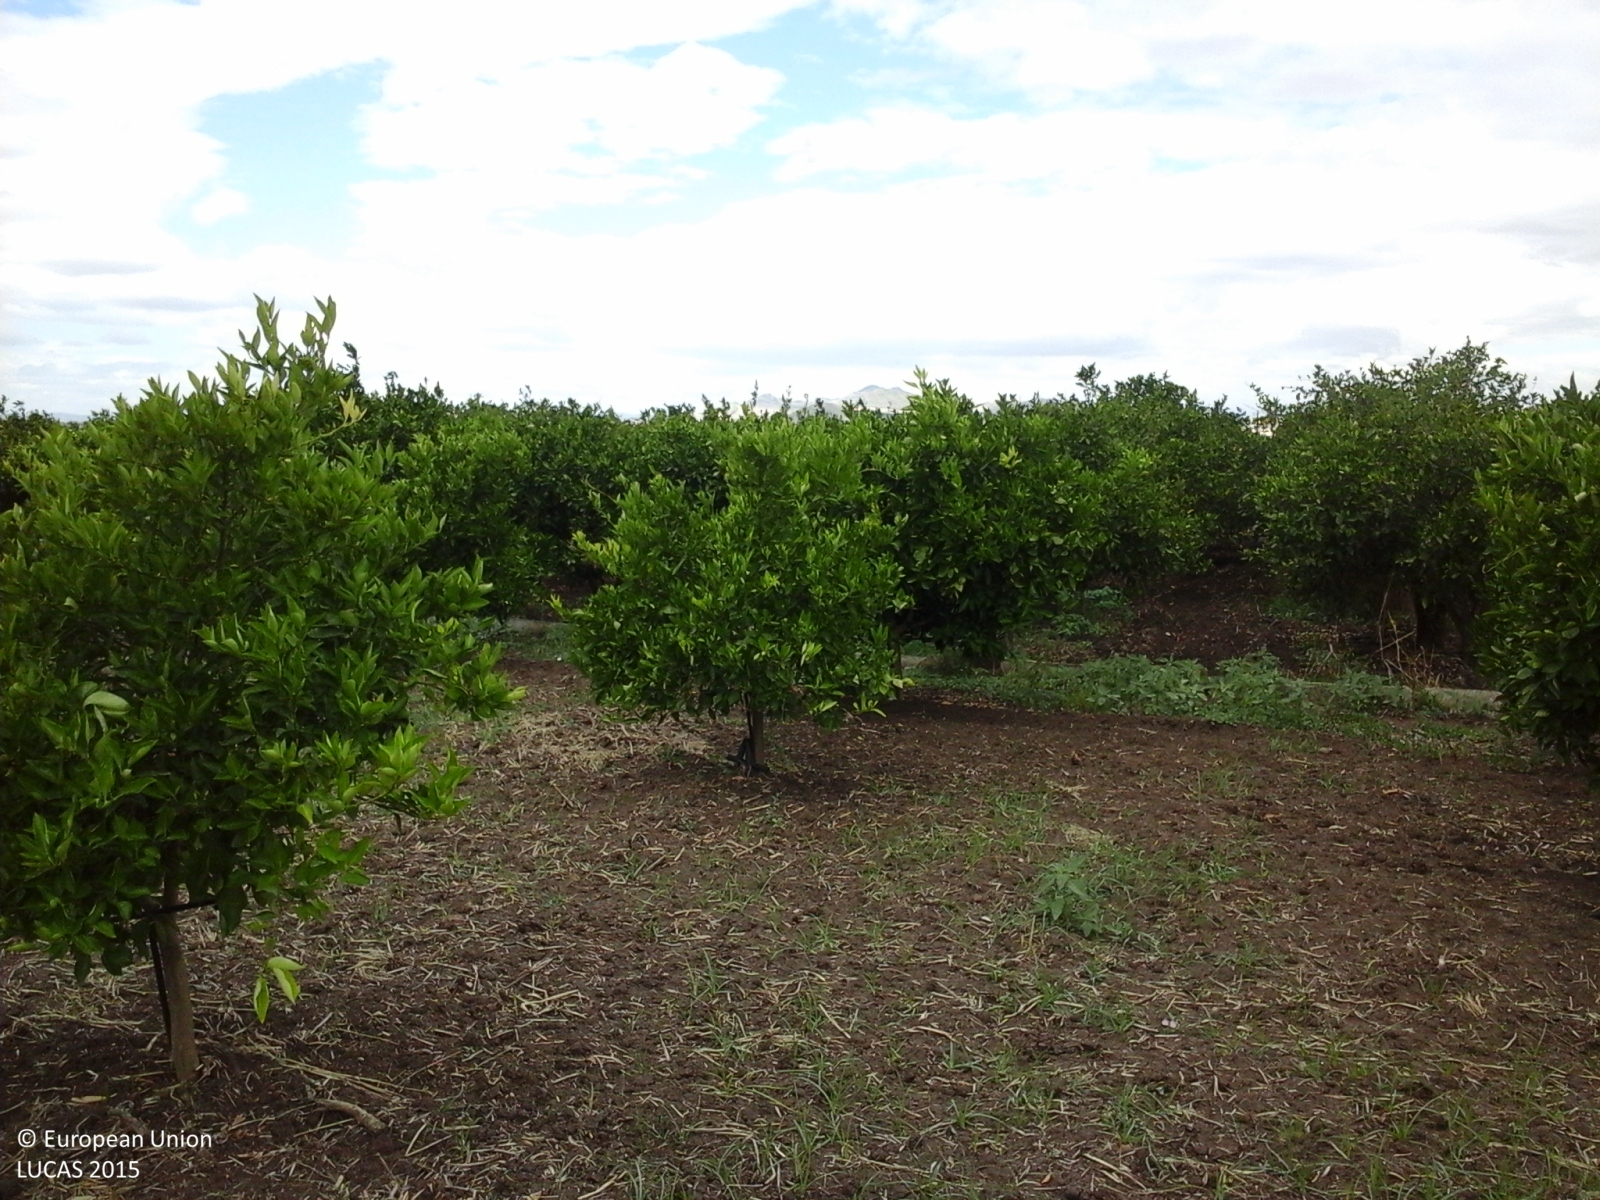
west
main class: Cropland
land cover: Oranges
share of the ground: > 75 %
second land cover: Spontaneously vegetated surfaces
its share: > 75 %
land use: Agriculture (excluding fallow land and kitchen gardens)
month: June
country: IT
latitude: 37.4970
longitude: 14.8399
